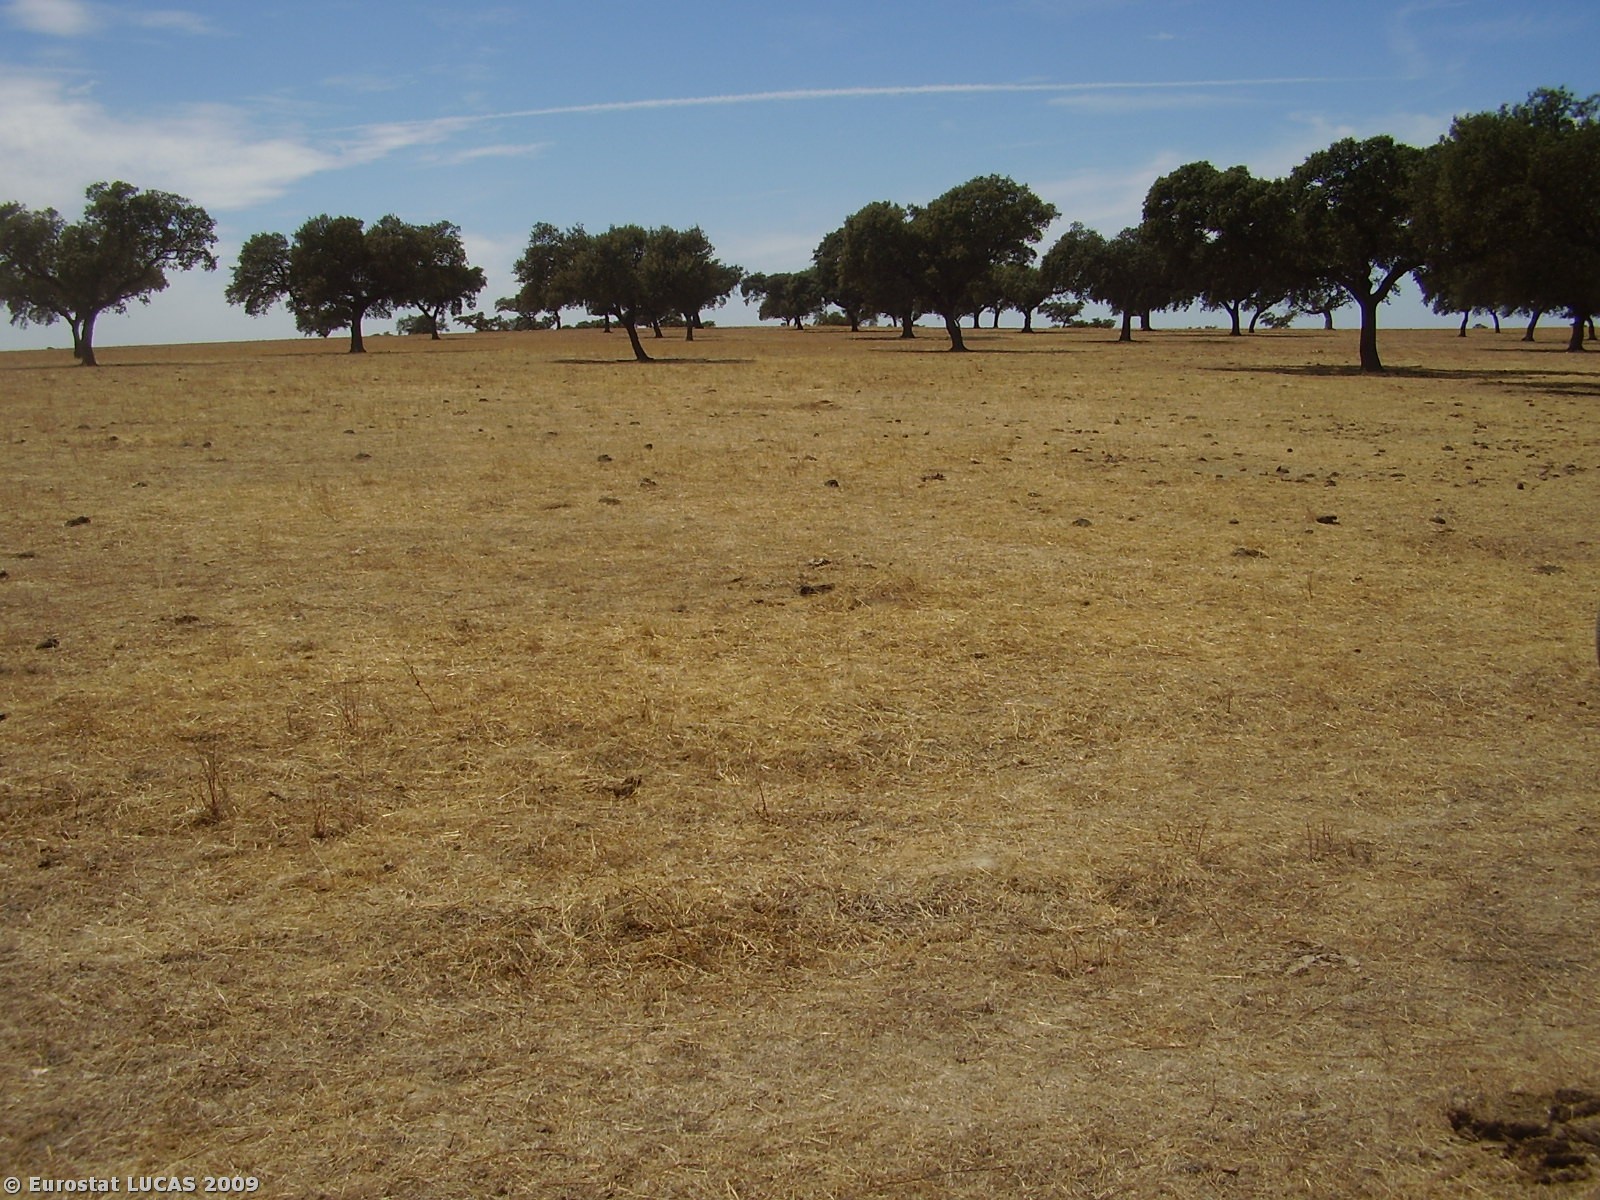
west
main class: Woodland
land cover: Broadleaved woodland
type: broadleaved evergreen forest
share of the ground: 10 - 25 %
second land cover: Grassland with sparse tree/shrub cover
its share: > 75 %
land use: Forestry
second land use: Fallow land
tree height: > 5 m
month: August
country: PT
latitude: 38.2607
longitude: -7.1712
